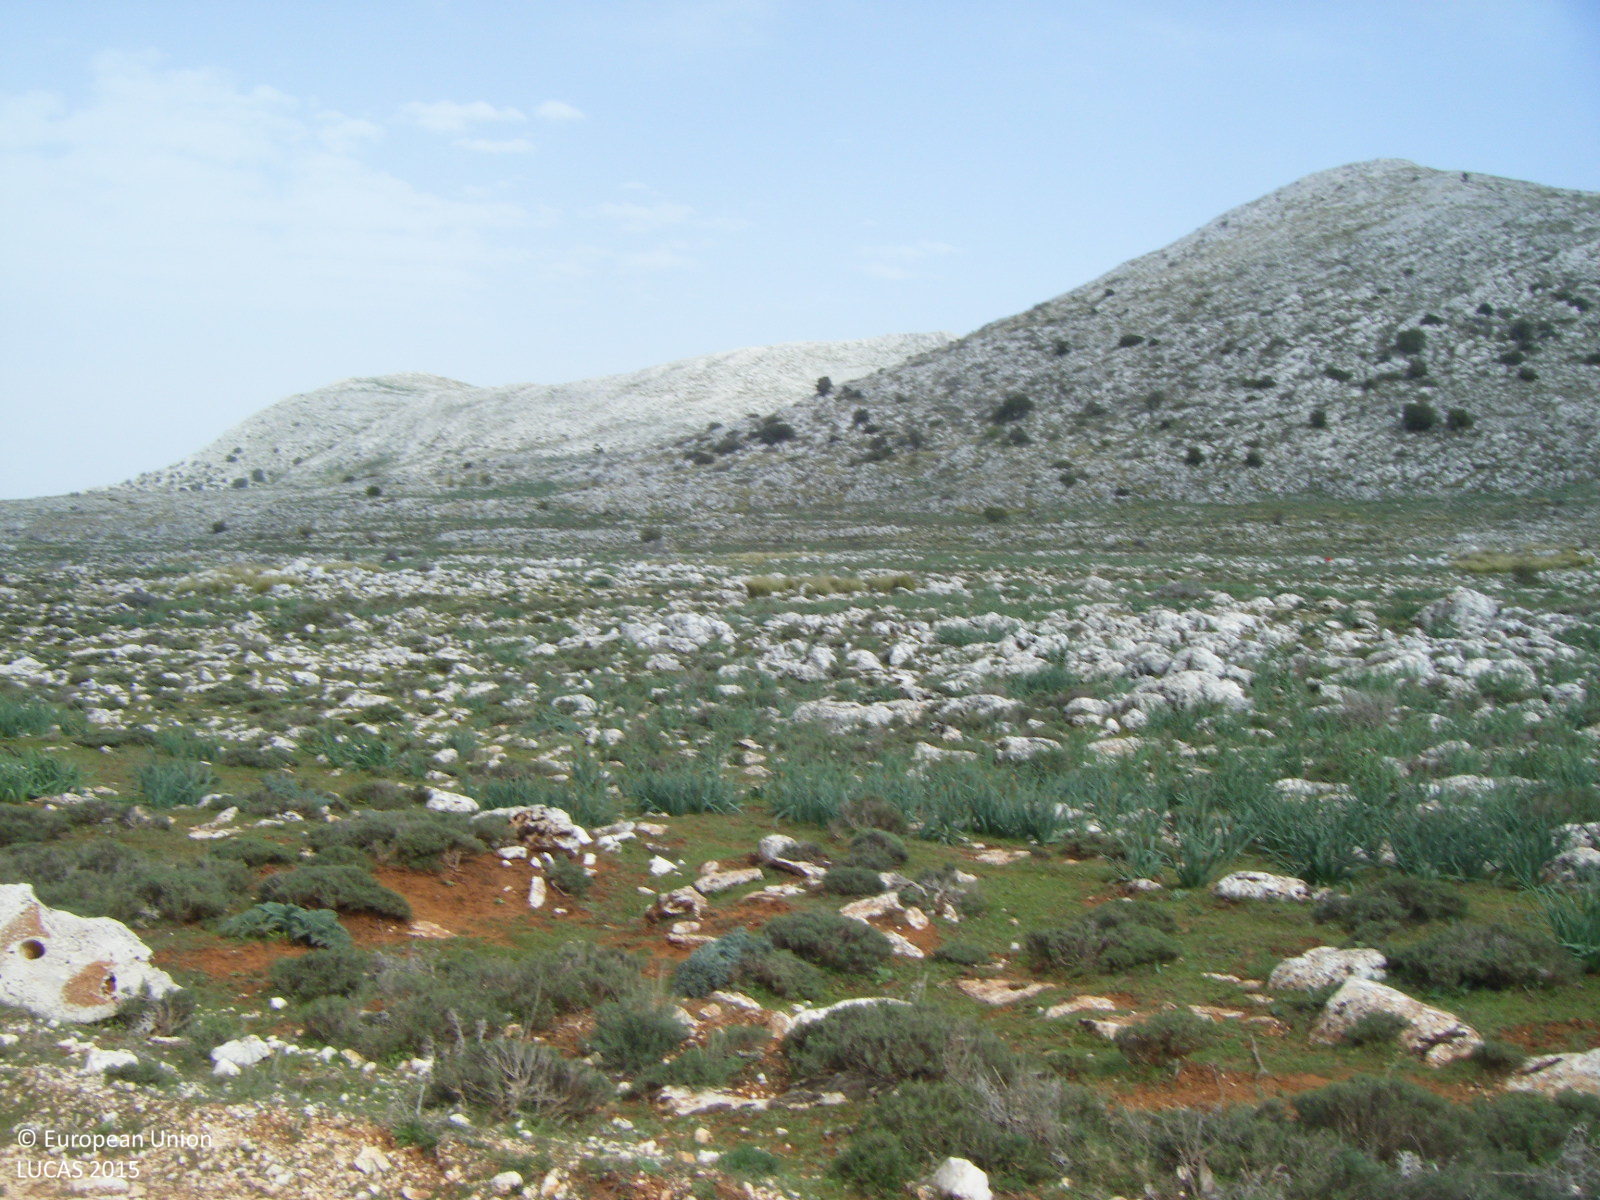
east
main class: Grassland
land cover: Grassland without tree/shrub cover
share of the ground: 50 - 75 %
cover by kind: herbaceous plants 50 %, consolidated bare surface 50 %
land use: Agriculture (excluding fallow land and kitchen gardens)
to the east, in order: Grassland without tree/shrub cover; Shrubland without tree cover; Grassland without tree/shrub cover
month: April
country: ES
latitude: 37.0903
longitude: -4.1348
